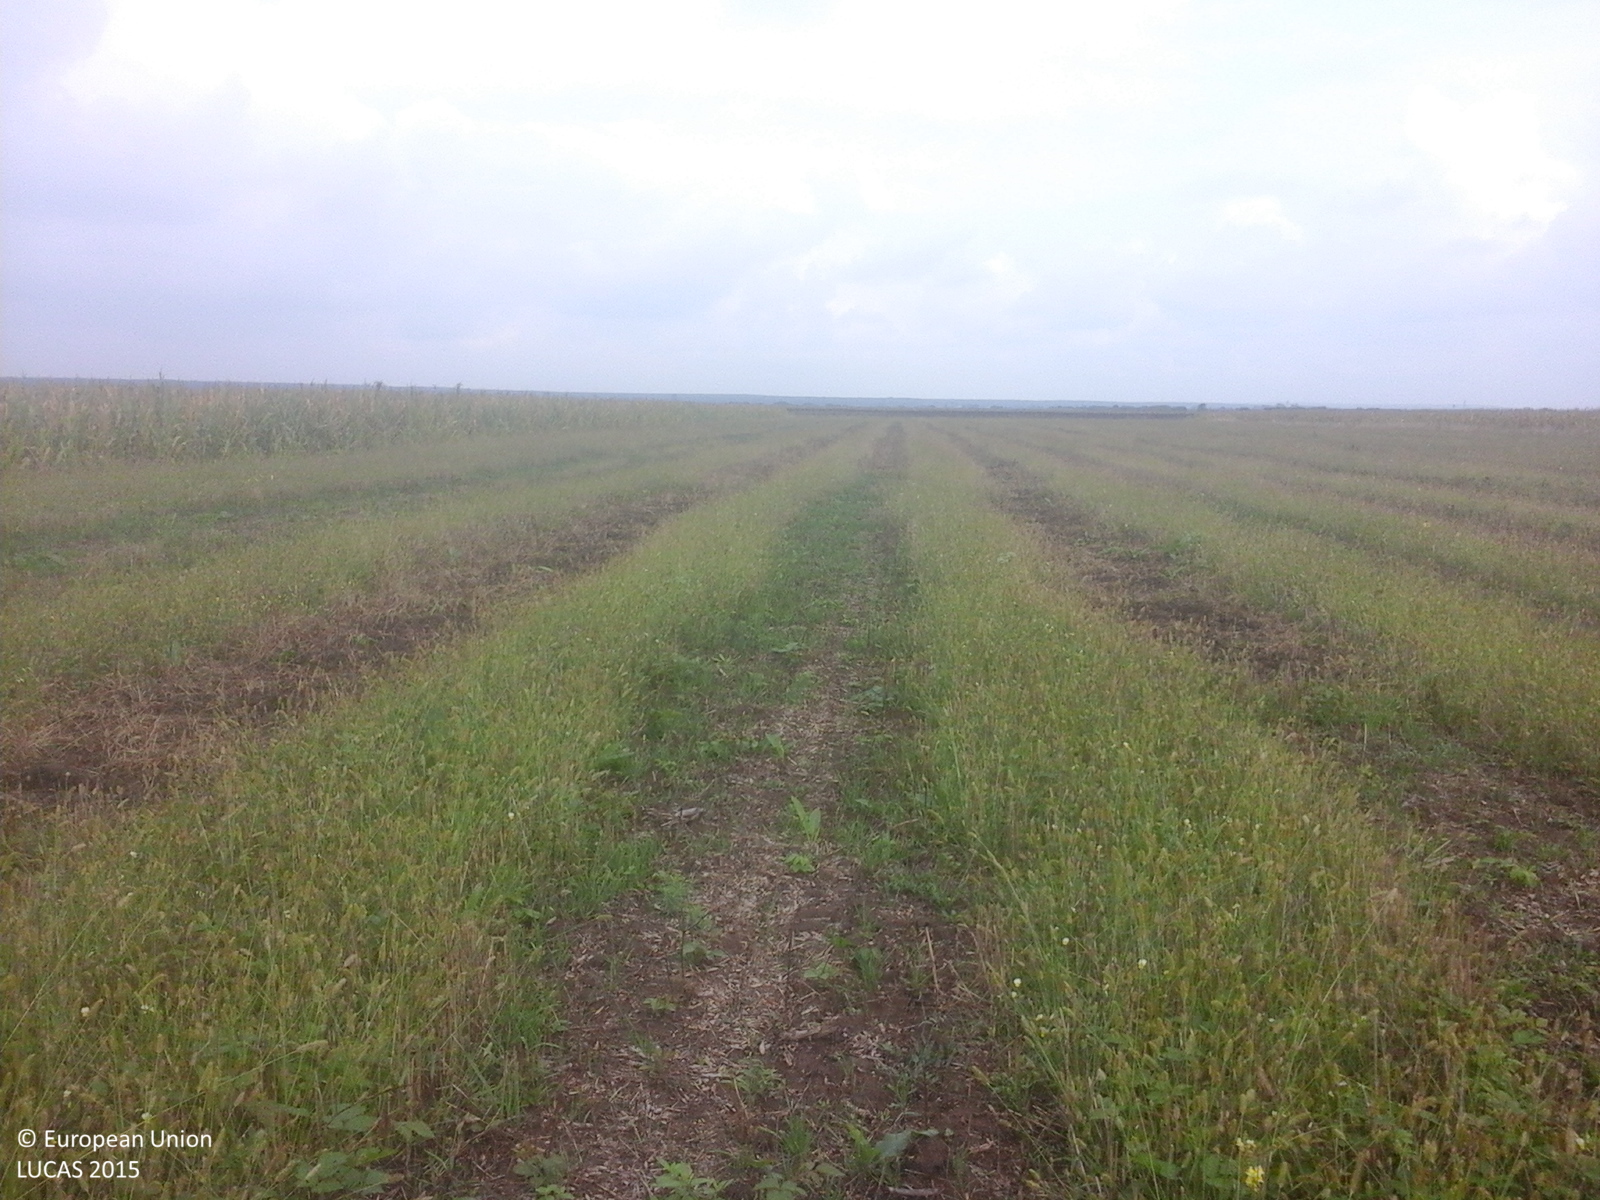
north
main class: Cropland
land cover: Common wheat
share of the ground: 10 - 25 %
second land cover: Spontaneously vegetated surfaces
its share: 25 - 50 %
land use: Agriculture (excluding fallow land and kitchen gardens)
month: September
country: RO
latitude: 46.7643
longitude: 21.8411
